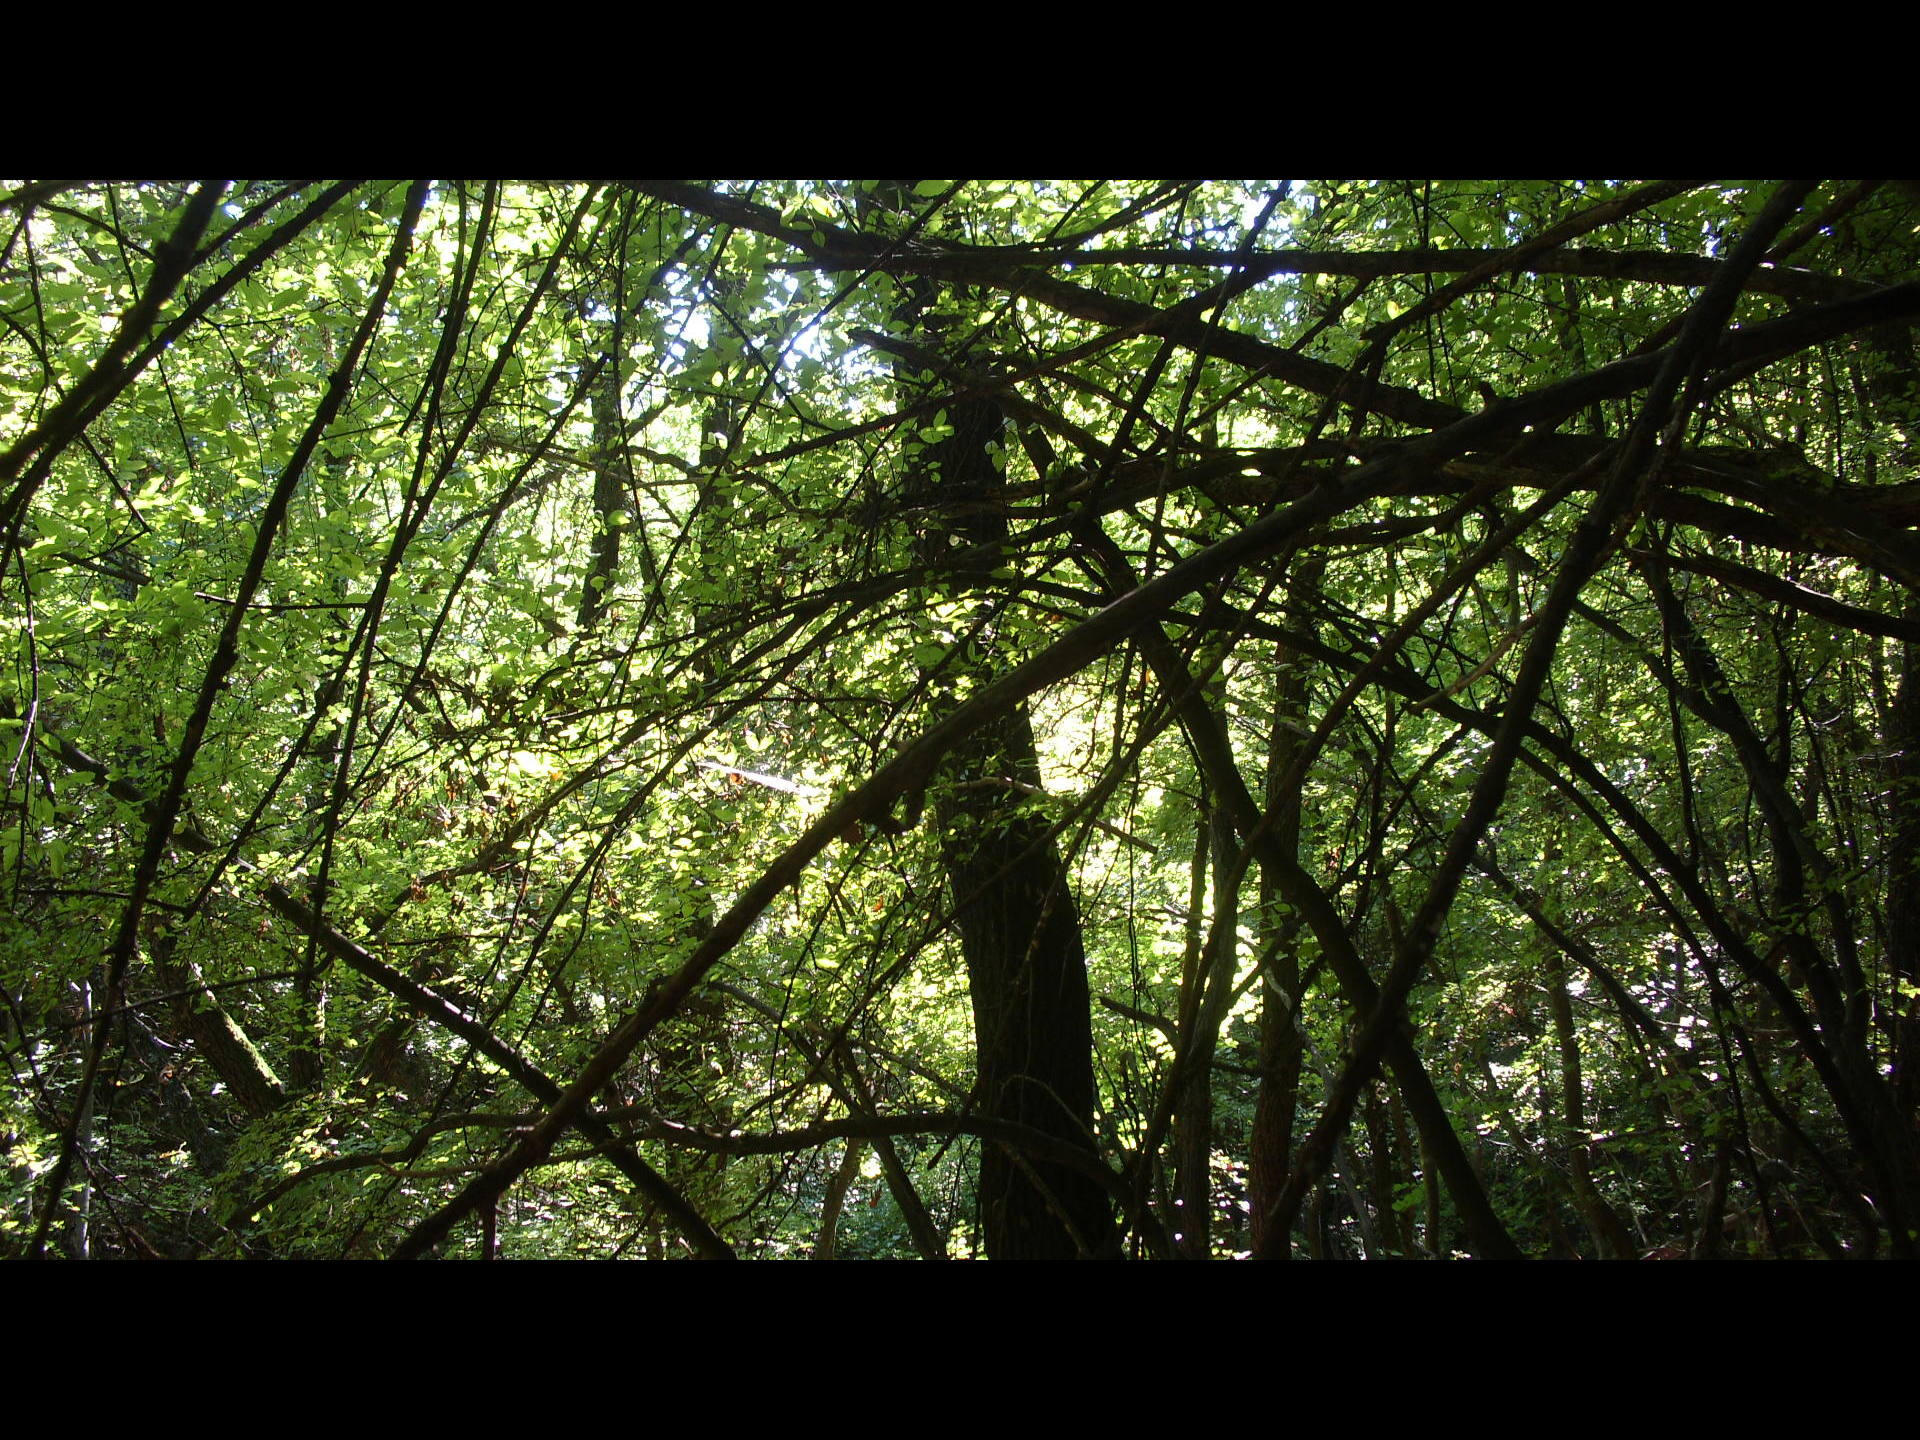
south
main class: Woodland
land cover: Broadleaved woodland
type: mesophytic deciduous forest
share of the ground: > 75 %
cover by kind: broadleaved forest trees 80 %, unconsolidated bare surface 20 %
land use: Forestry
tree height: > 5 m
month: October
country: BG
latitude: 43.8954
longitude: 22.6969
